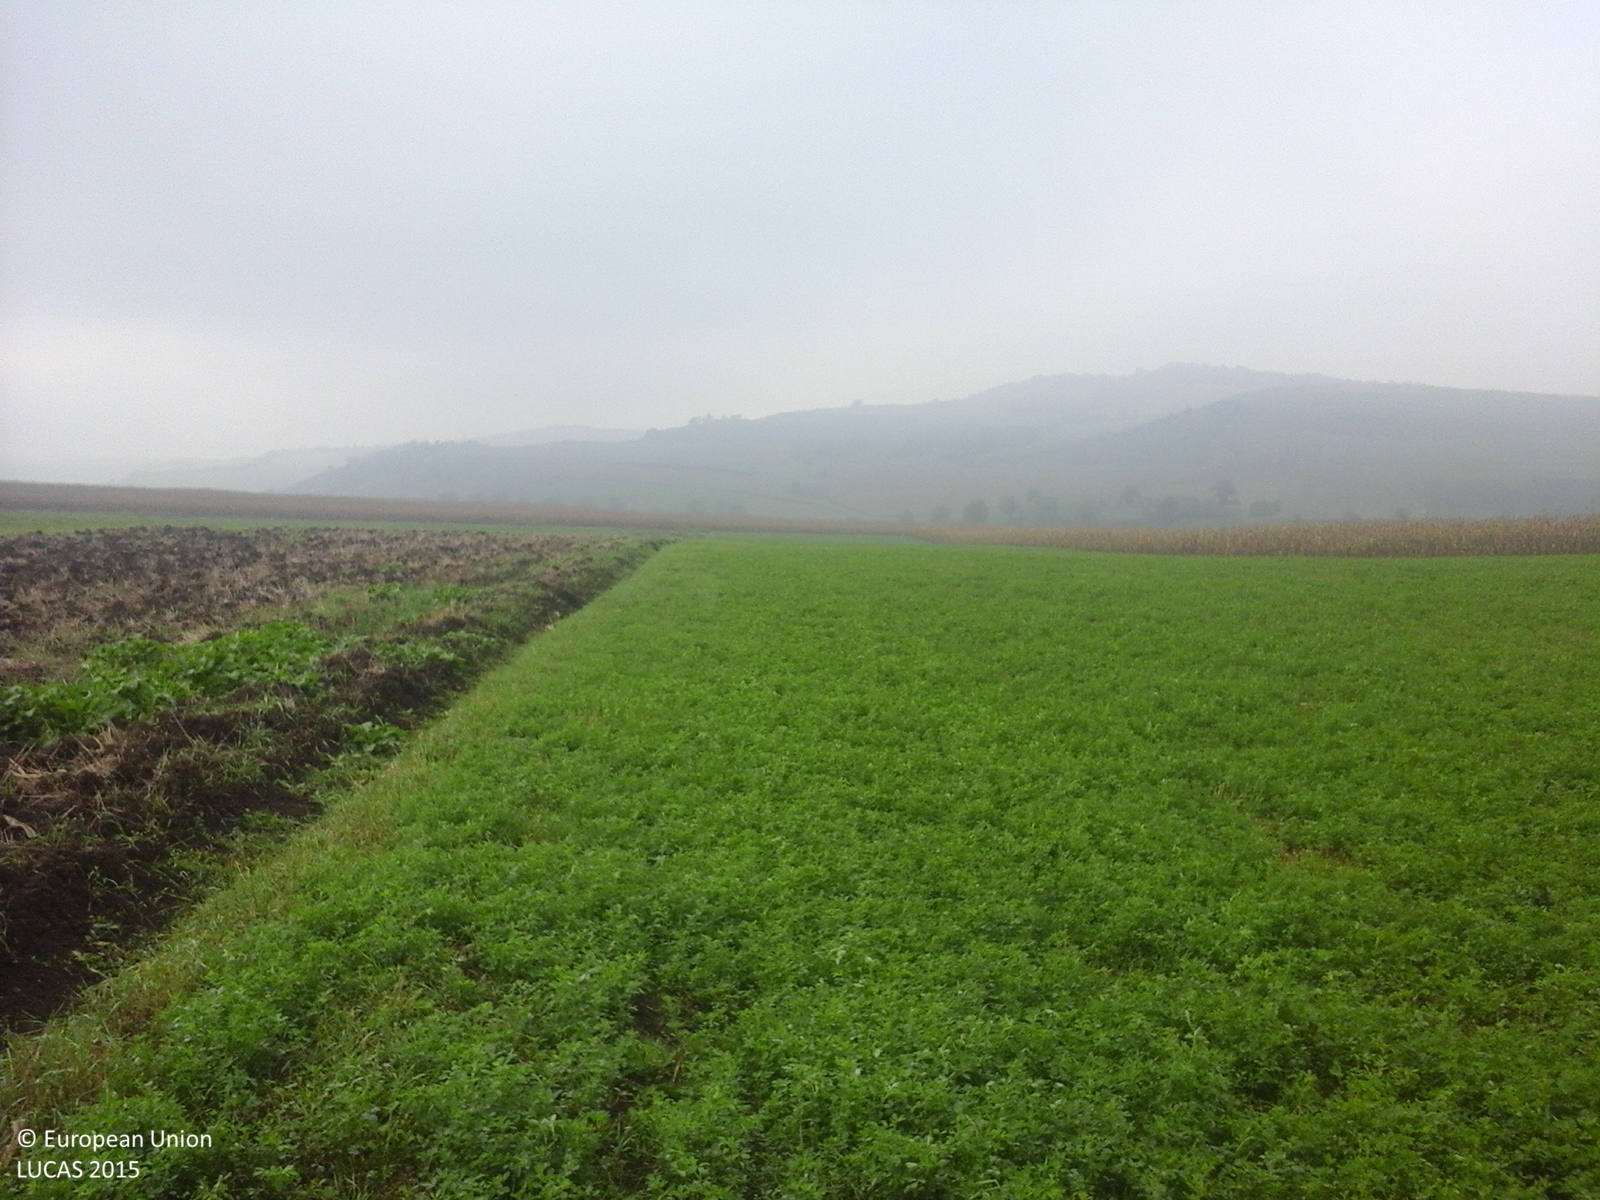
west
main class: Cropland
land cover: Lucerne
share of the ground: > 75 %
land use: Agriculture (excluding fallow land and kitchen gardens)
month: October
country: RO
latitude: 46.5279
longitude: 24.3595
